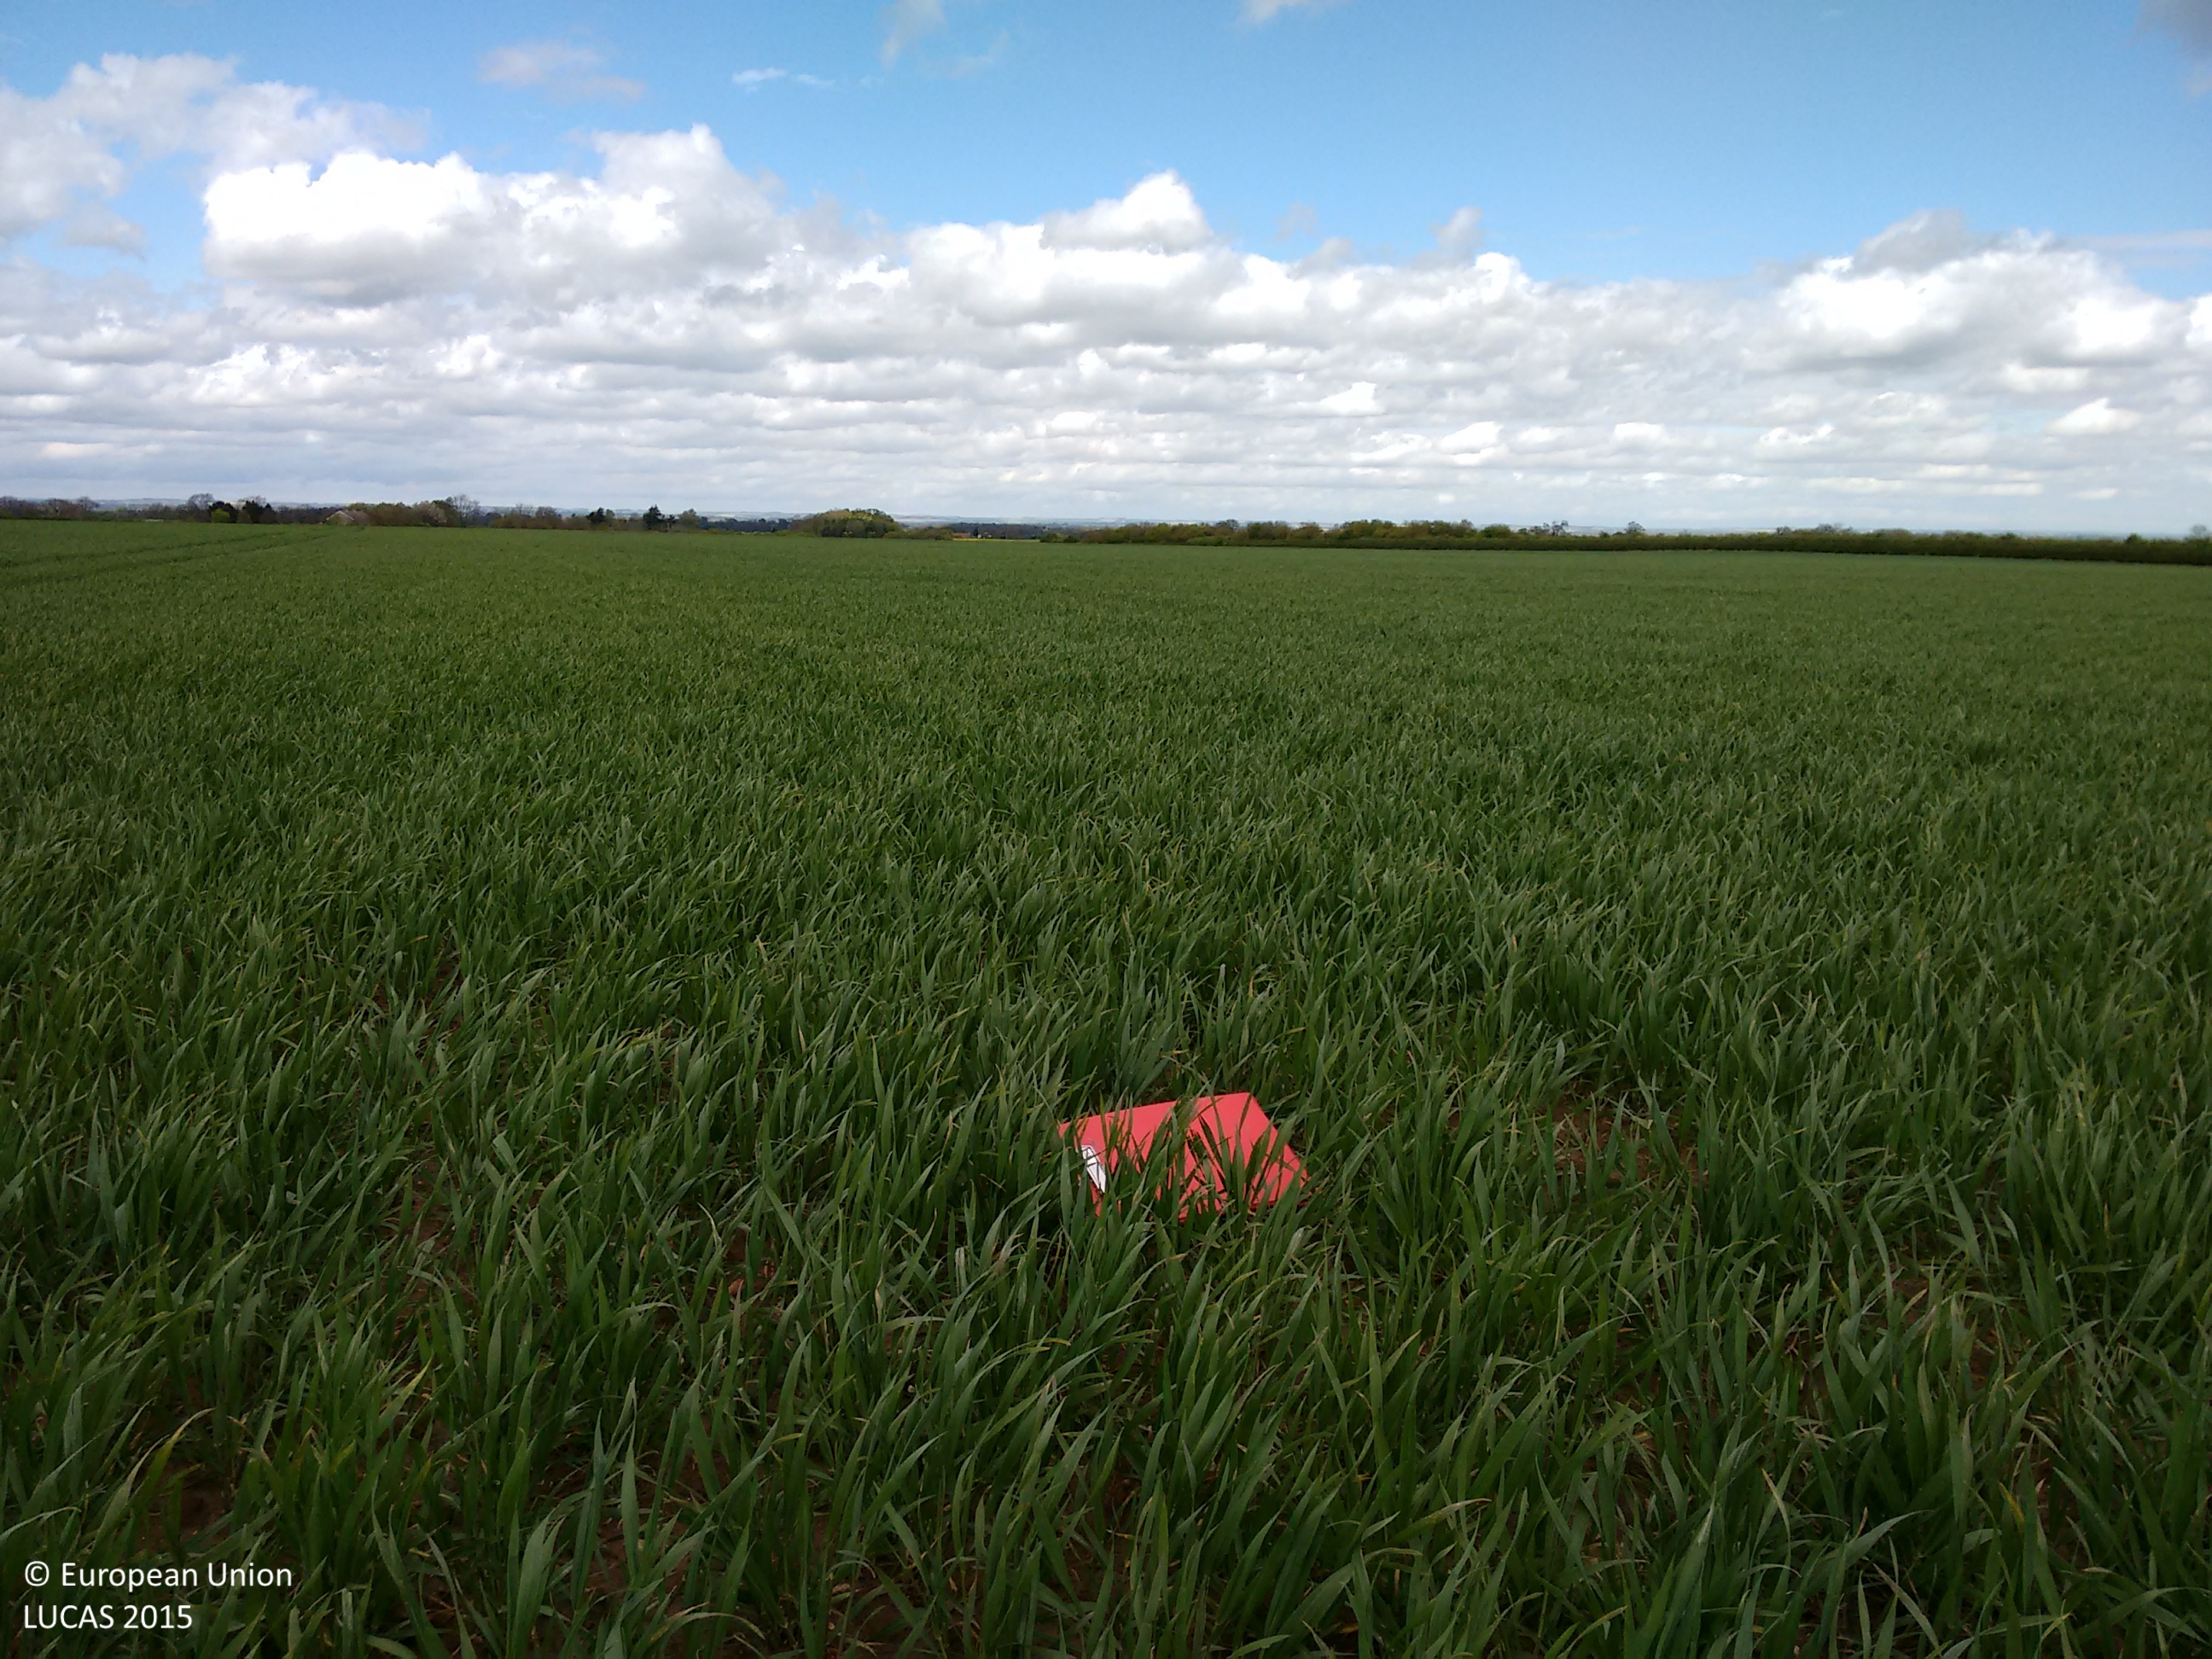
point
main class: Cropland
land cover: Common wheat
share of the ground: > 75 %
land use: Agriculture (excluding fallow land and kitchen gardens)
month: May
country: GB
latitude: 53.8349
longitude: -0.4759
